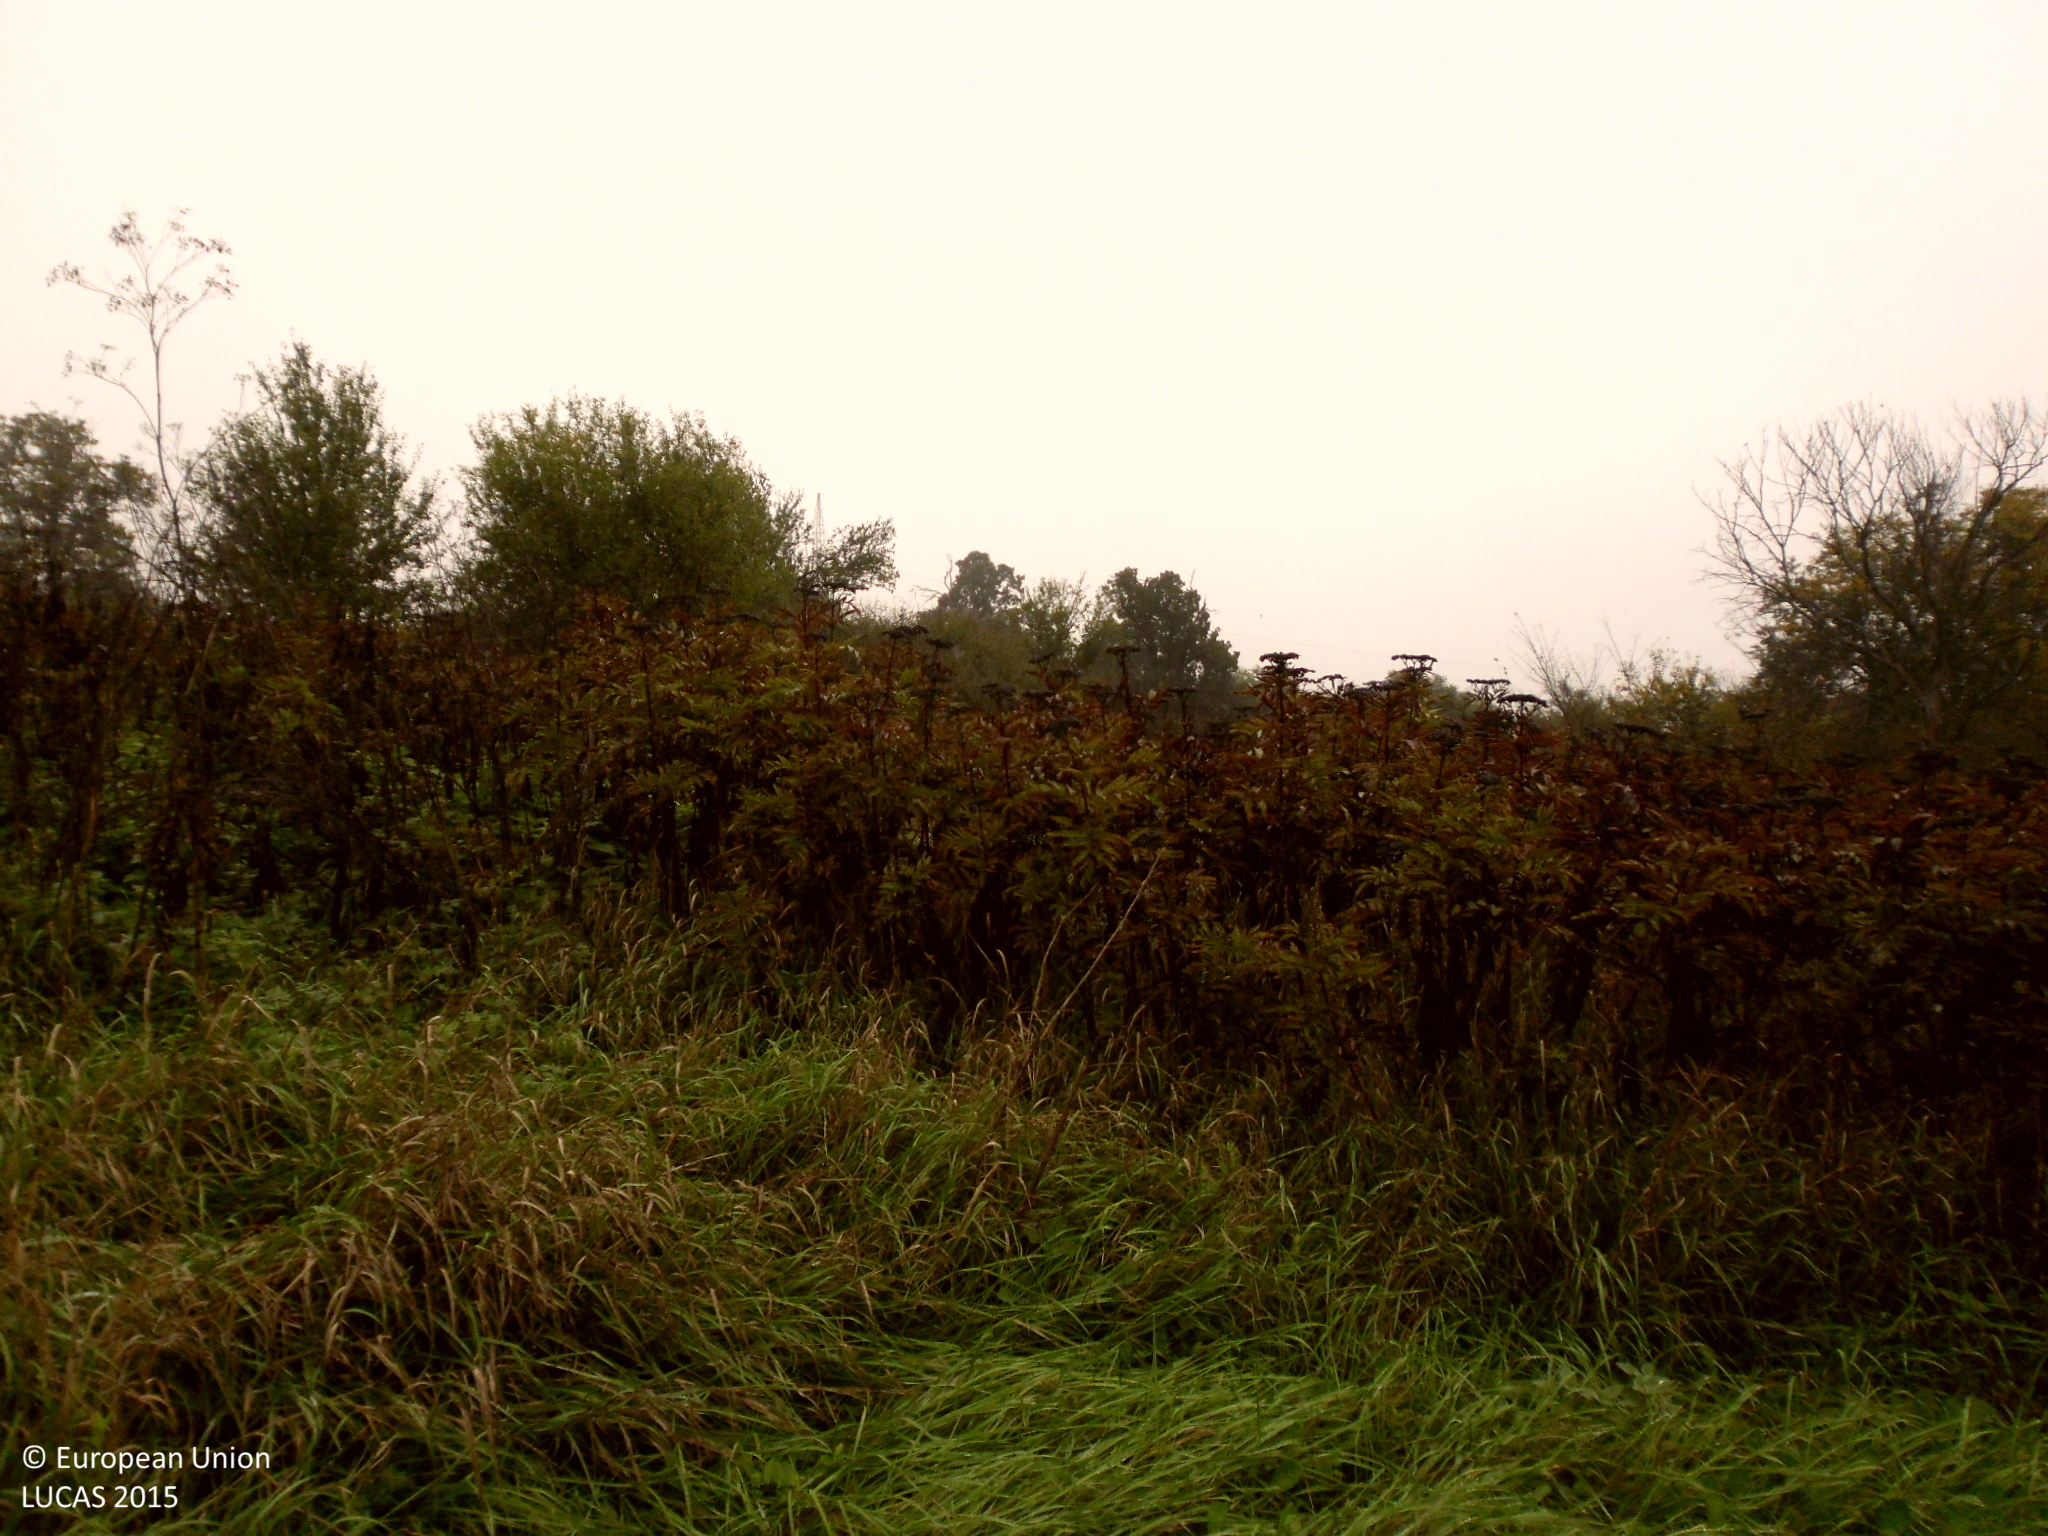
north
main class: Grassland
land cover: Grassland without tree/shrub cover
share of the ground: > 75 %
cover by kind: herbaceous plants 95 %, shrubs 5 %
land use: Semi-natural and natural areas not in use
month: October
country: BG
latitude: 43.9019
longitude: 22.4964
